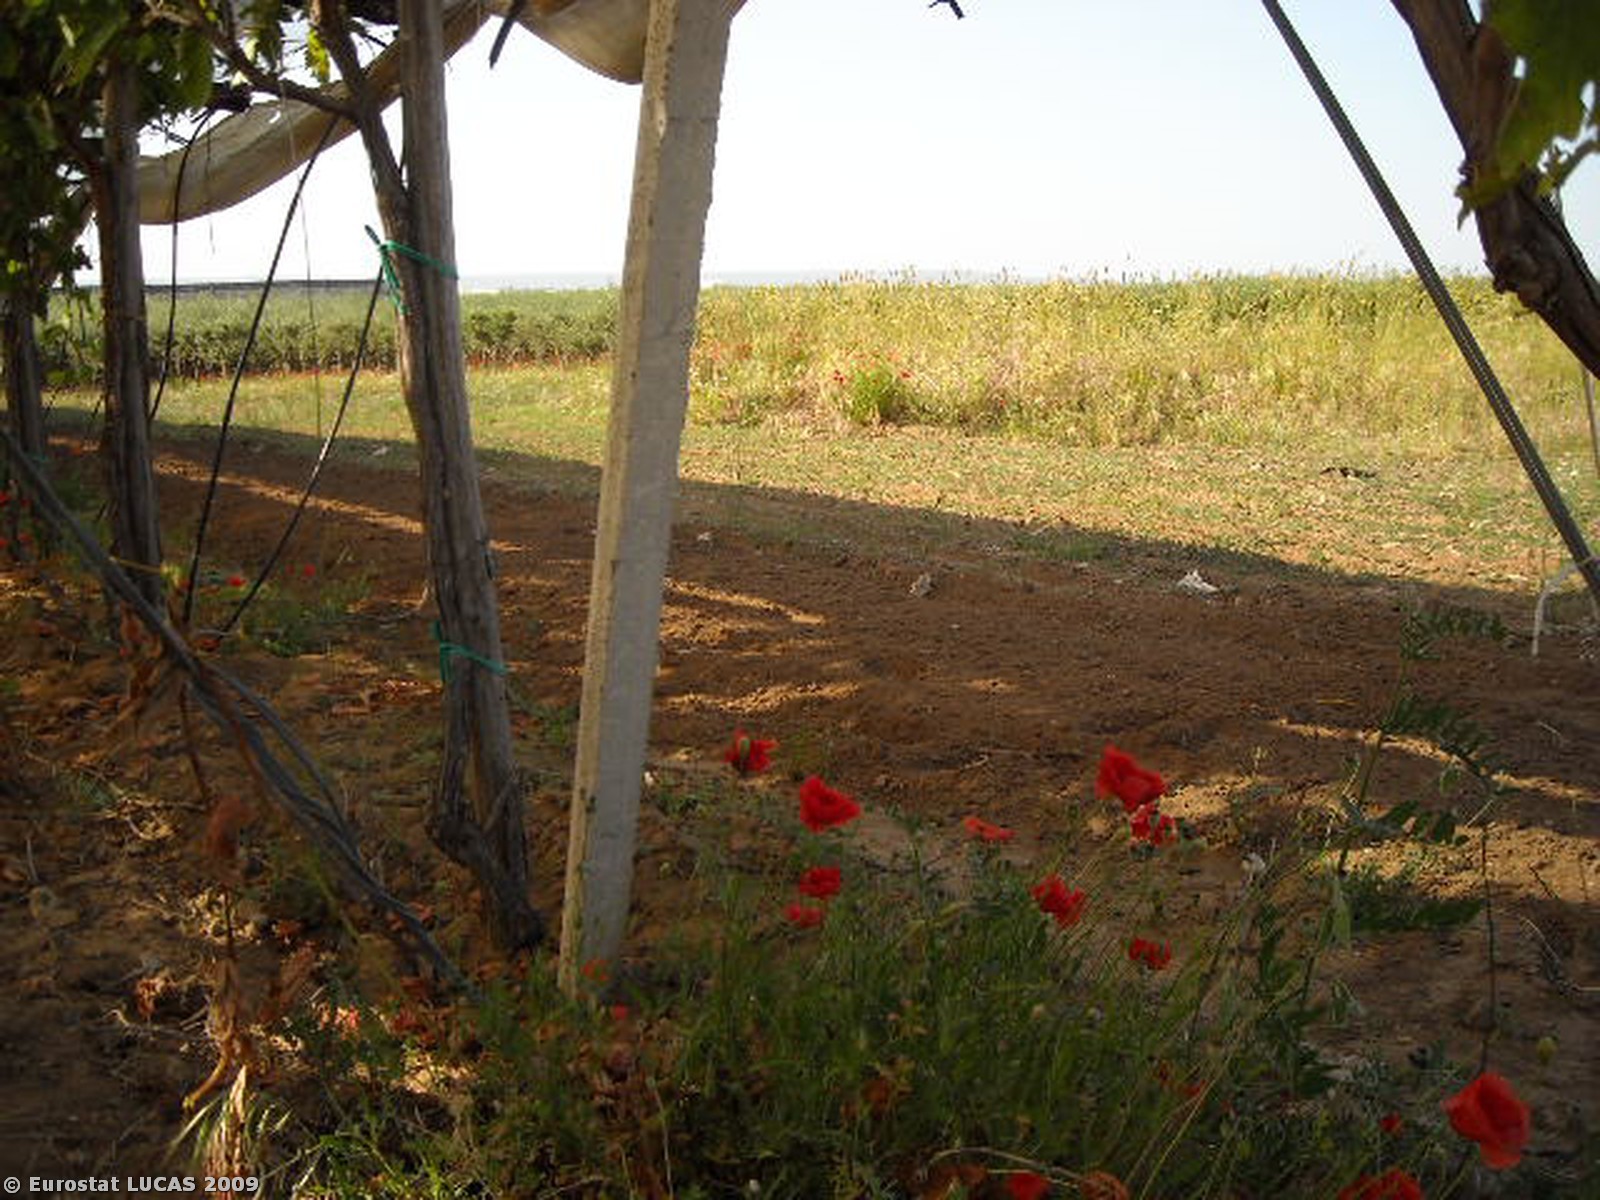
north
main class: Cropland
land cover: Vineyards
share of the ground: > 75 %
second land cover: Bare land
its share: > 75 %
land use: Agriculture (excluding fallow land and kitchen gardens)
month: May
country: IT
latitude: 40.4650
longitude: 16.8277
